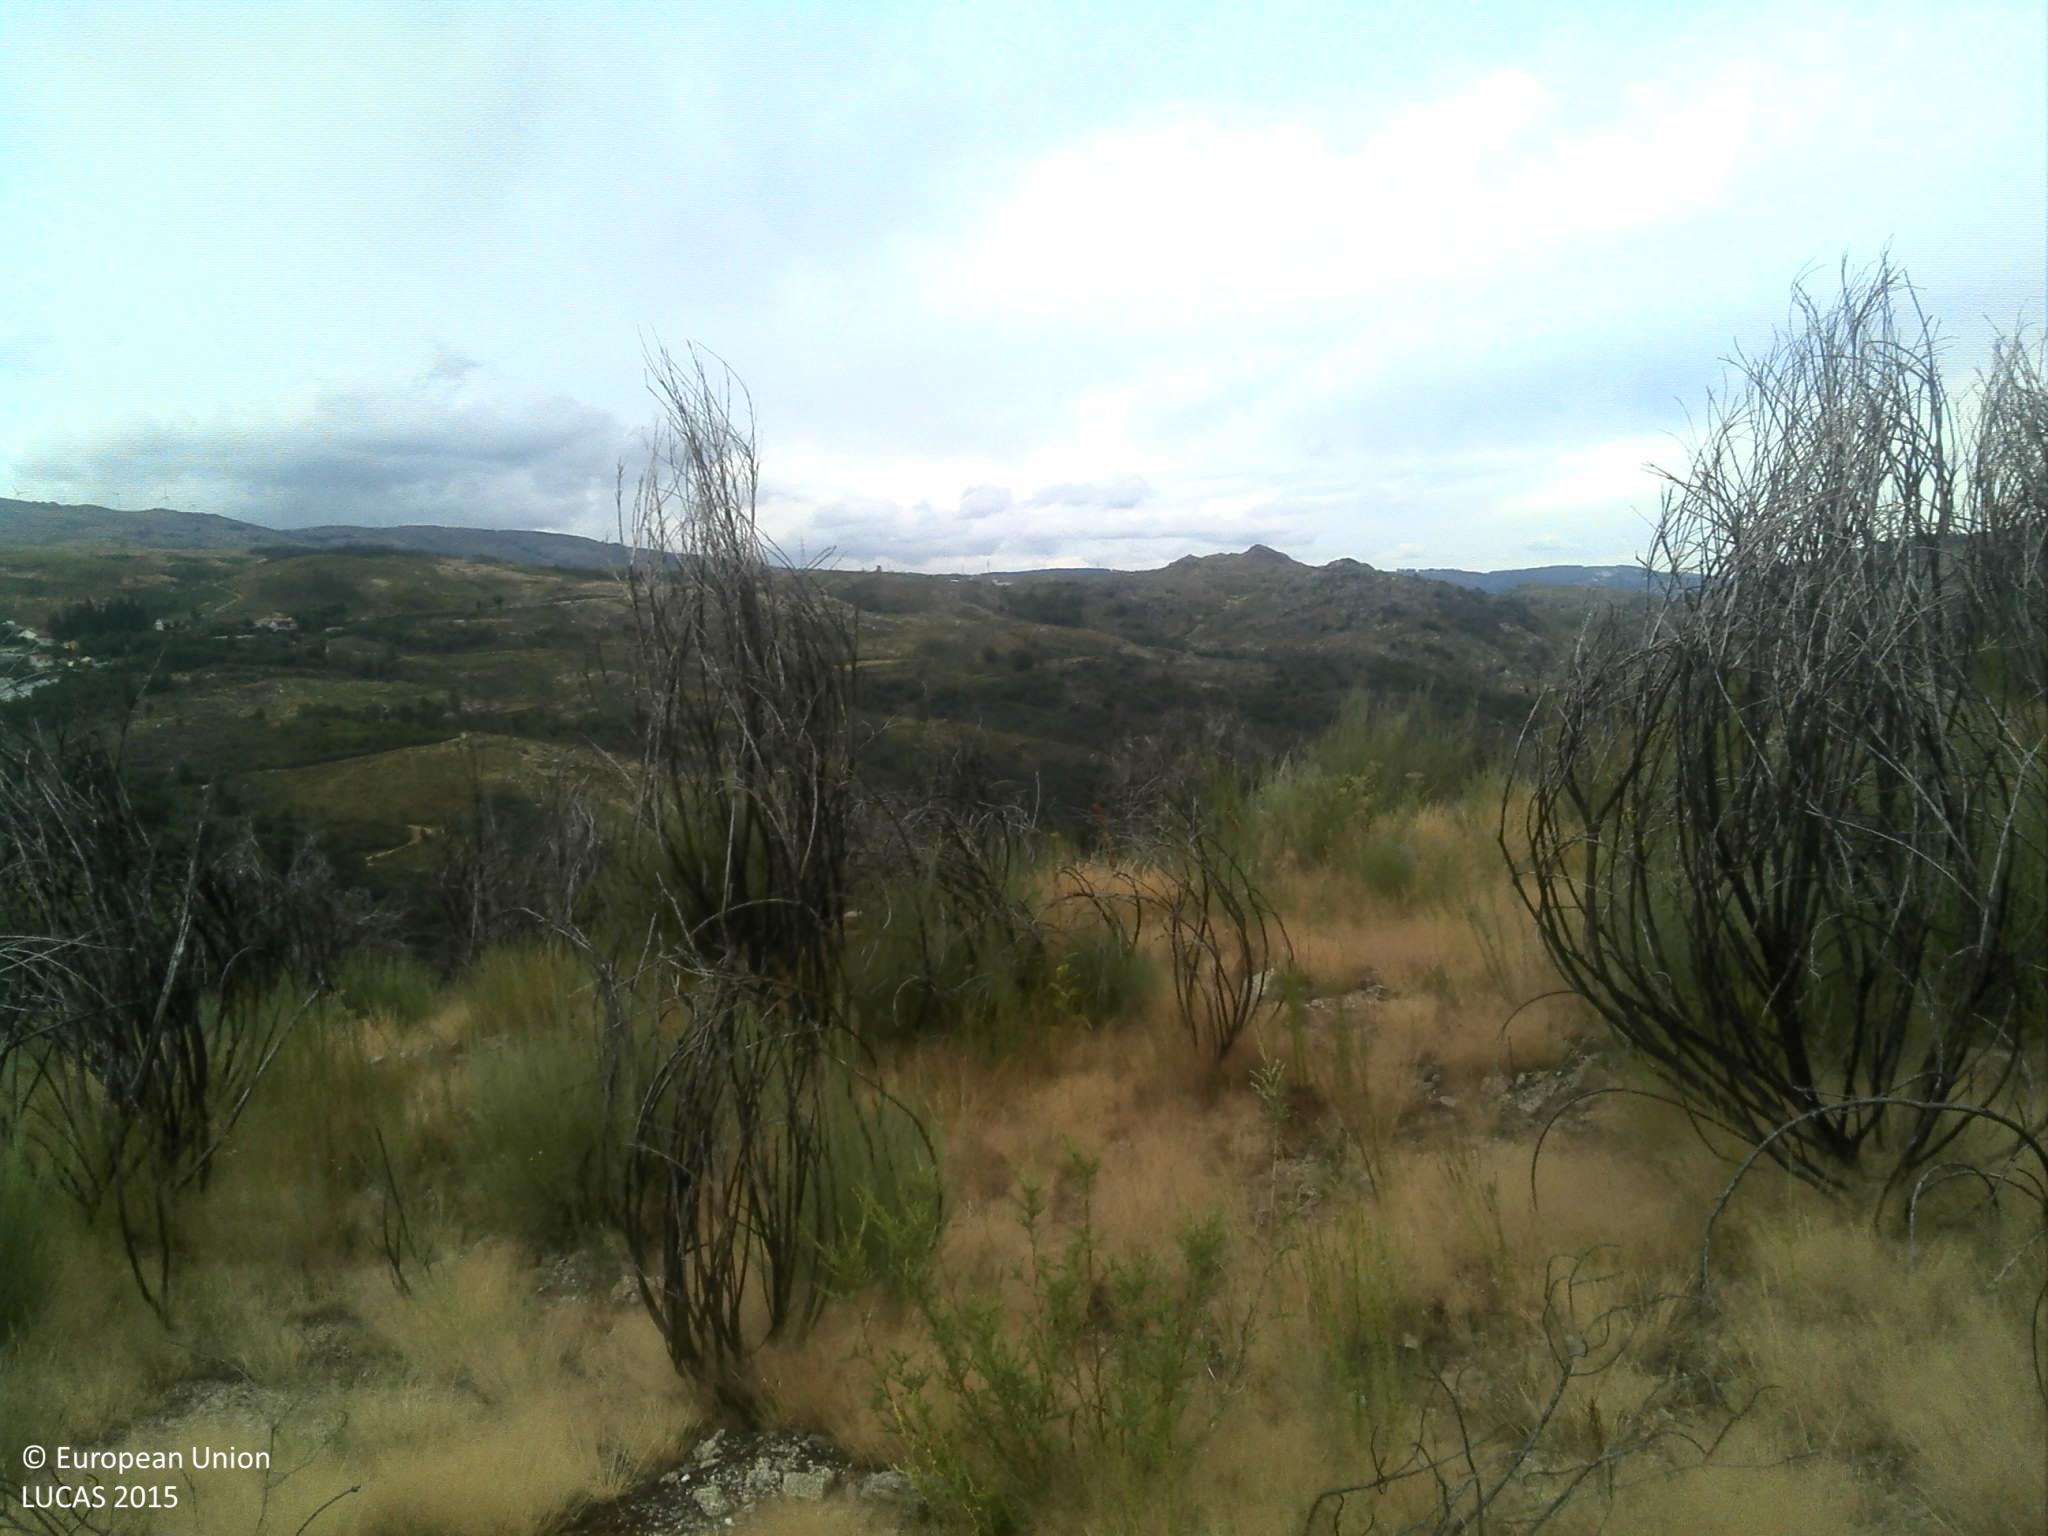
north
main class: Shrubland
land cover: Shrubland without tree cover
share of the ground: 50 - 75 %
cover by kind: shrubs 75 %, herbaceous plants 20 %, unconsolidated bare surface 5 %
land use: Semi-natural and natural areas not in use
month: July
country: PT
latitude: 41.3765
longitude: -7.6950
